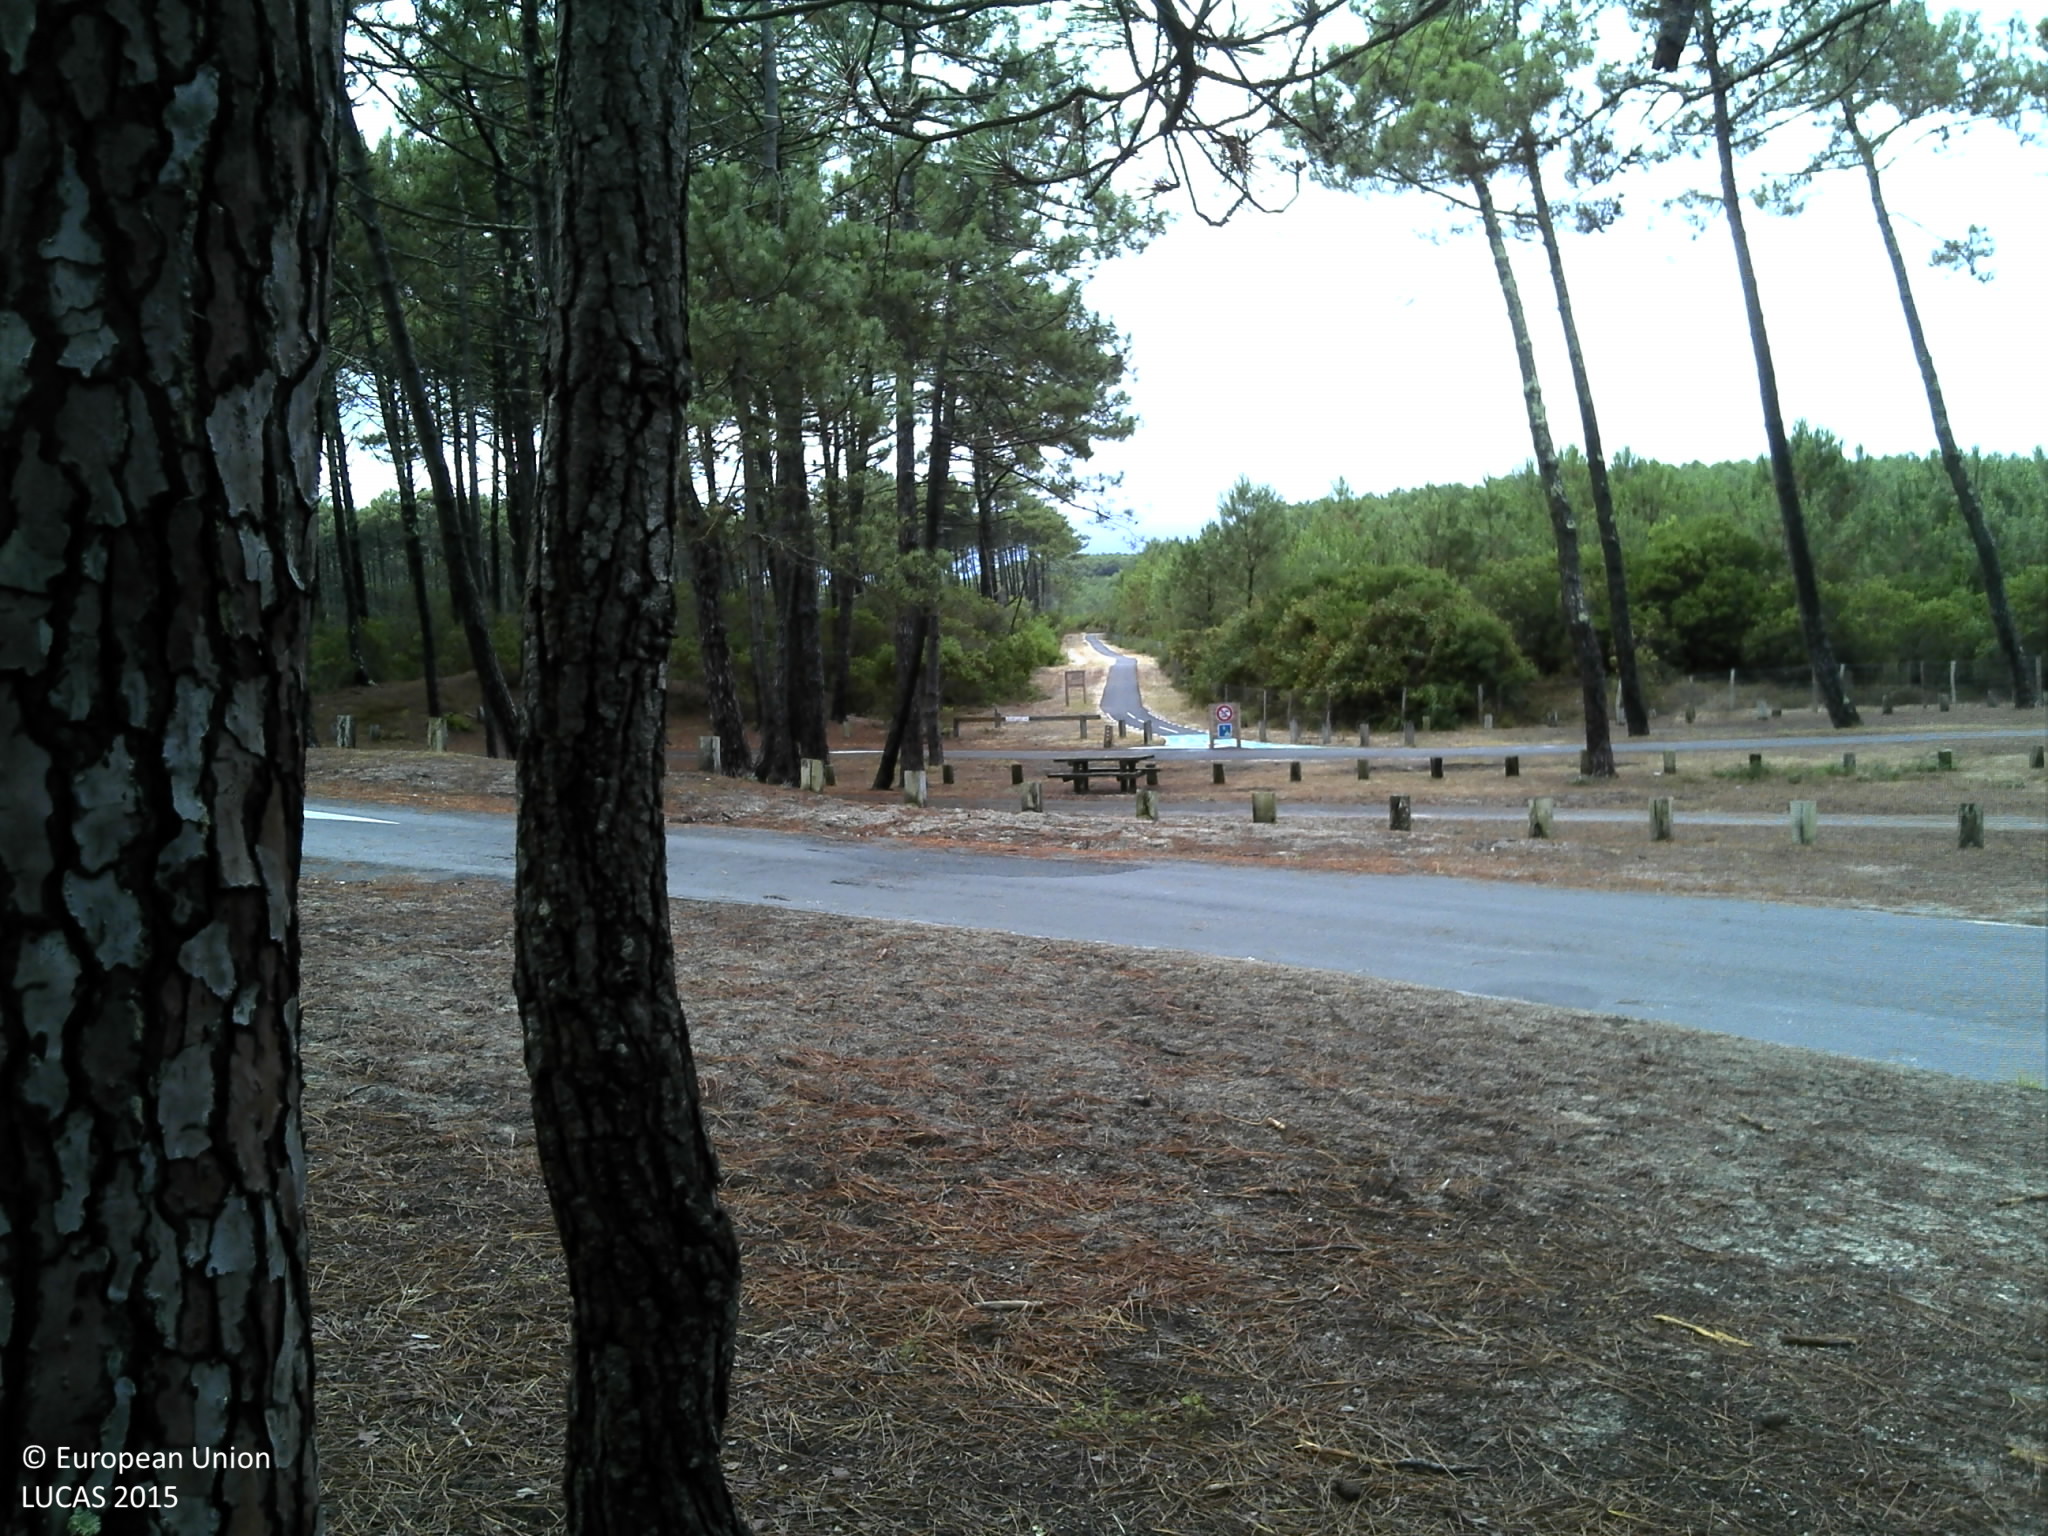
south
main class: Woodland
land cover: Pine dominated coniferous woodland
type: coniferous forest of the mediterranean region
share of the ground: > 75 %
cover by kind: coniferous forest trees 60 %, shrubs 30 %, herbaceous plants 5 %, lichens and mosses 5 %
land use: Forestry
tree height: > 5 m
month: July
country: FR
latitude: 44.5566
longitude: -1.2403
